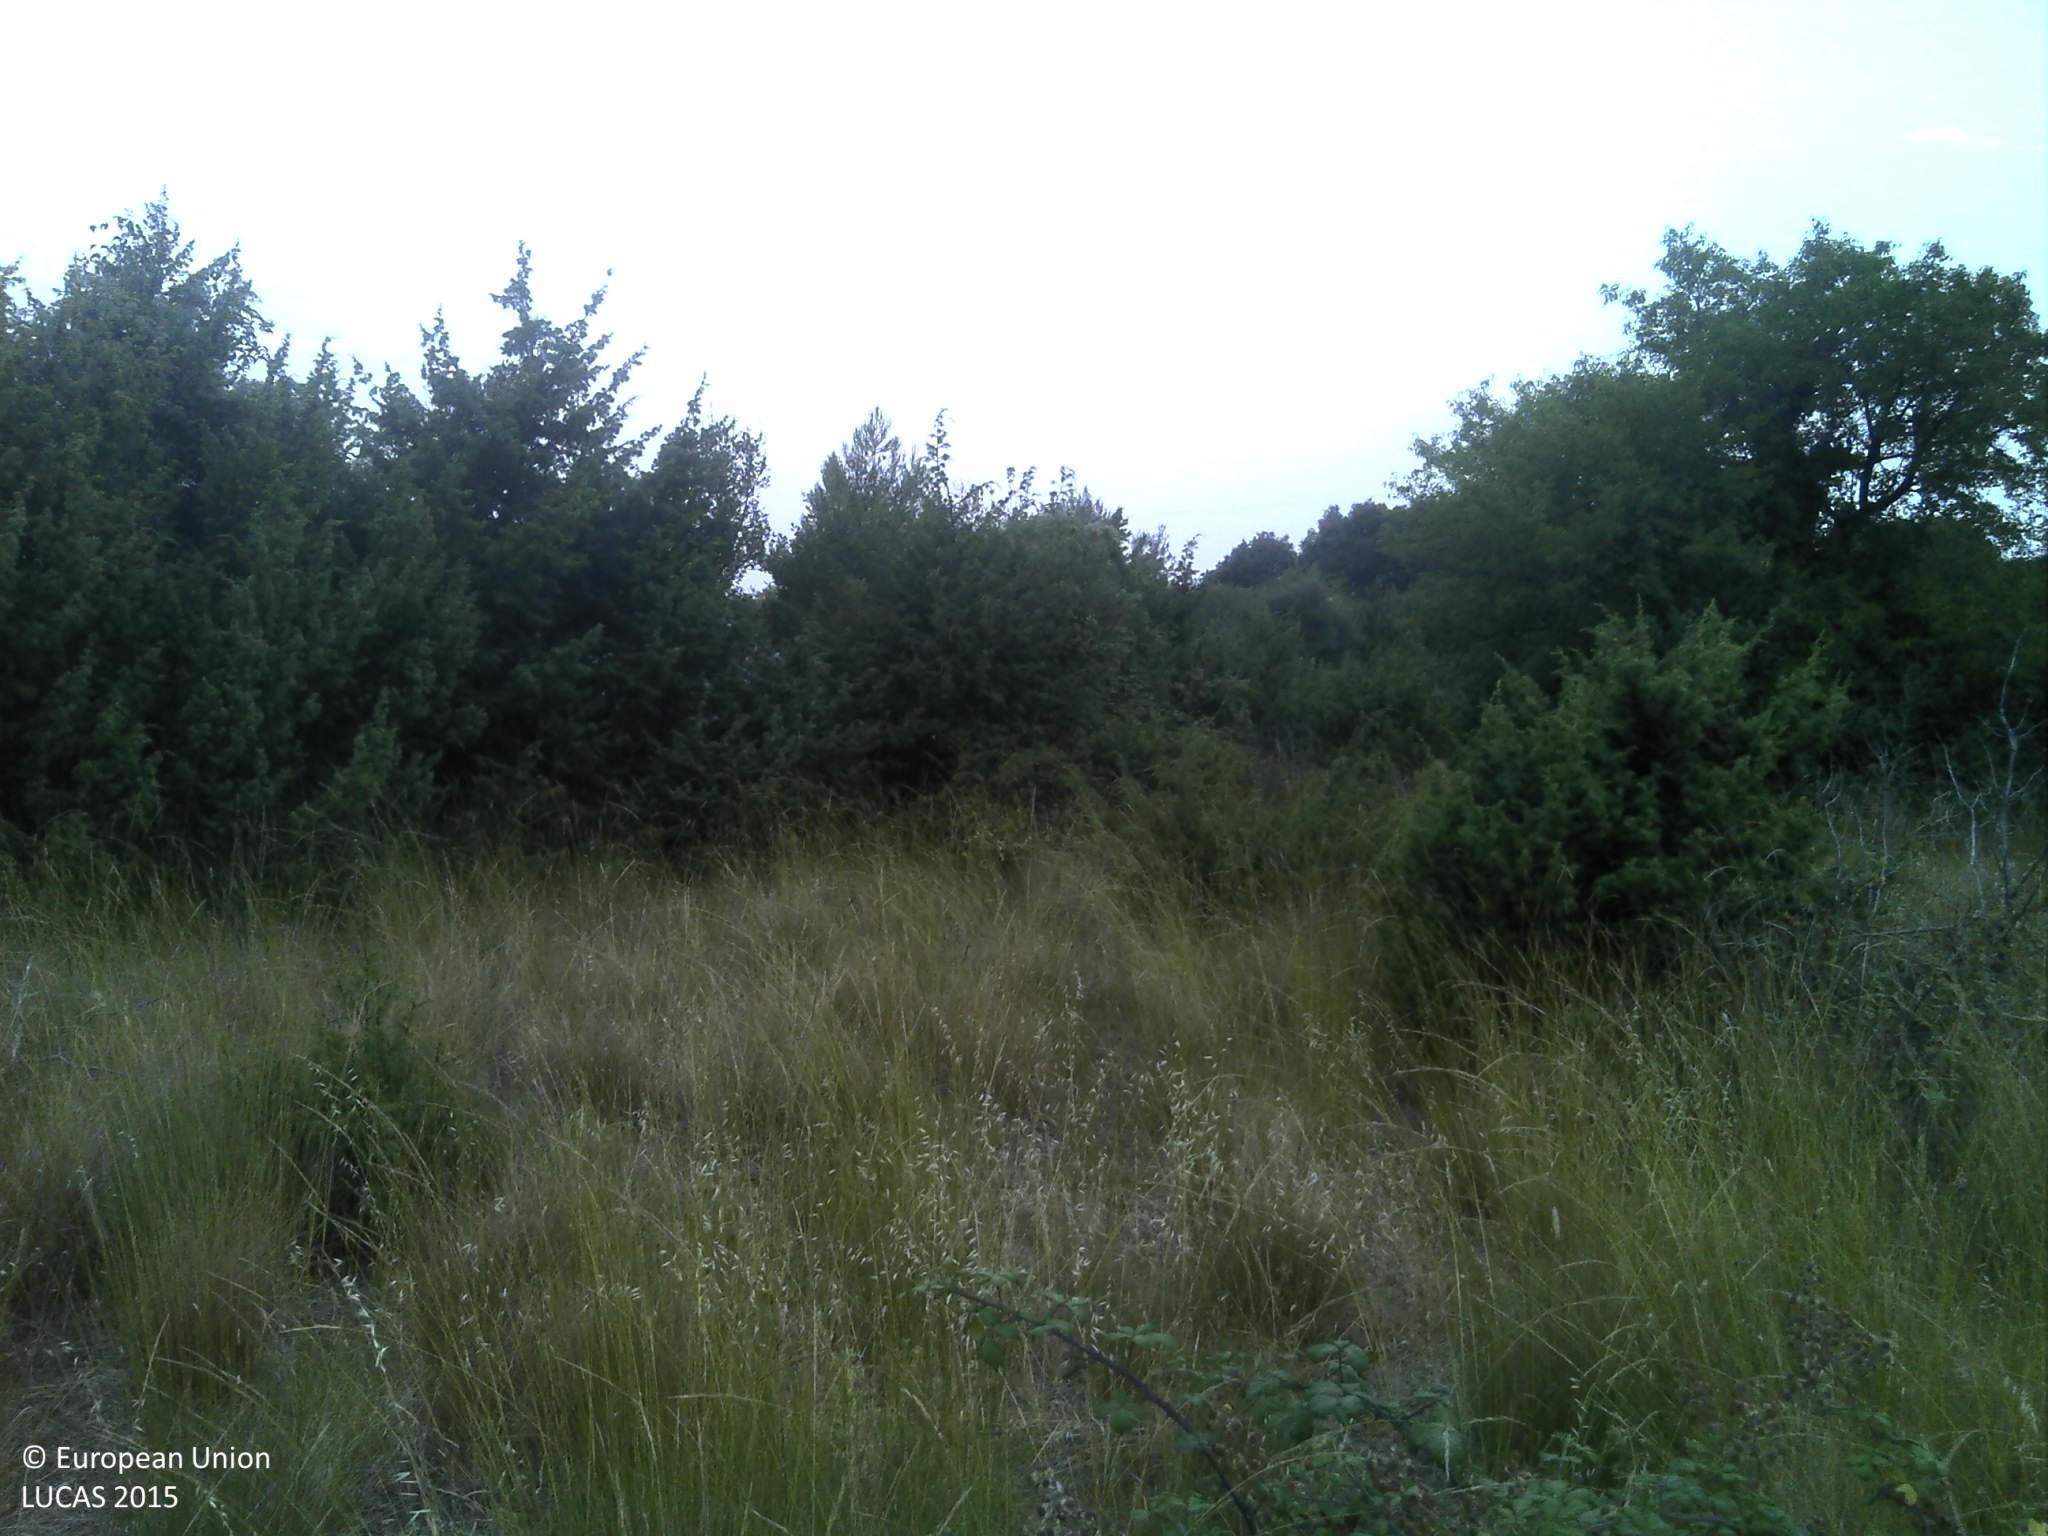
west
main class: Shrubland
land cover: Shrubland with sparse tree cover
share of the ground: > 75 %
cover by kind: herbaceous plants 70 %, shrubs 15 %, consolidated bare surface 10 %, broadleaved forest trees 5 %
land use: Agriculture (excluding fallow land and kitchen gardens)
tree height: < 5 m
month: July
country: HR
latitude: 43.3463
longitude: 16.5655
